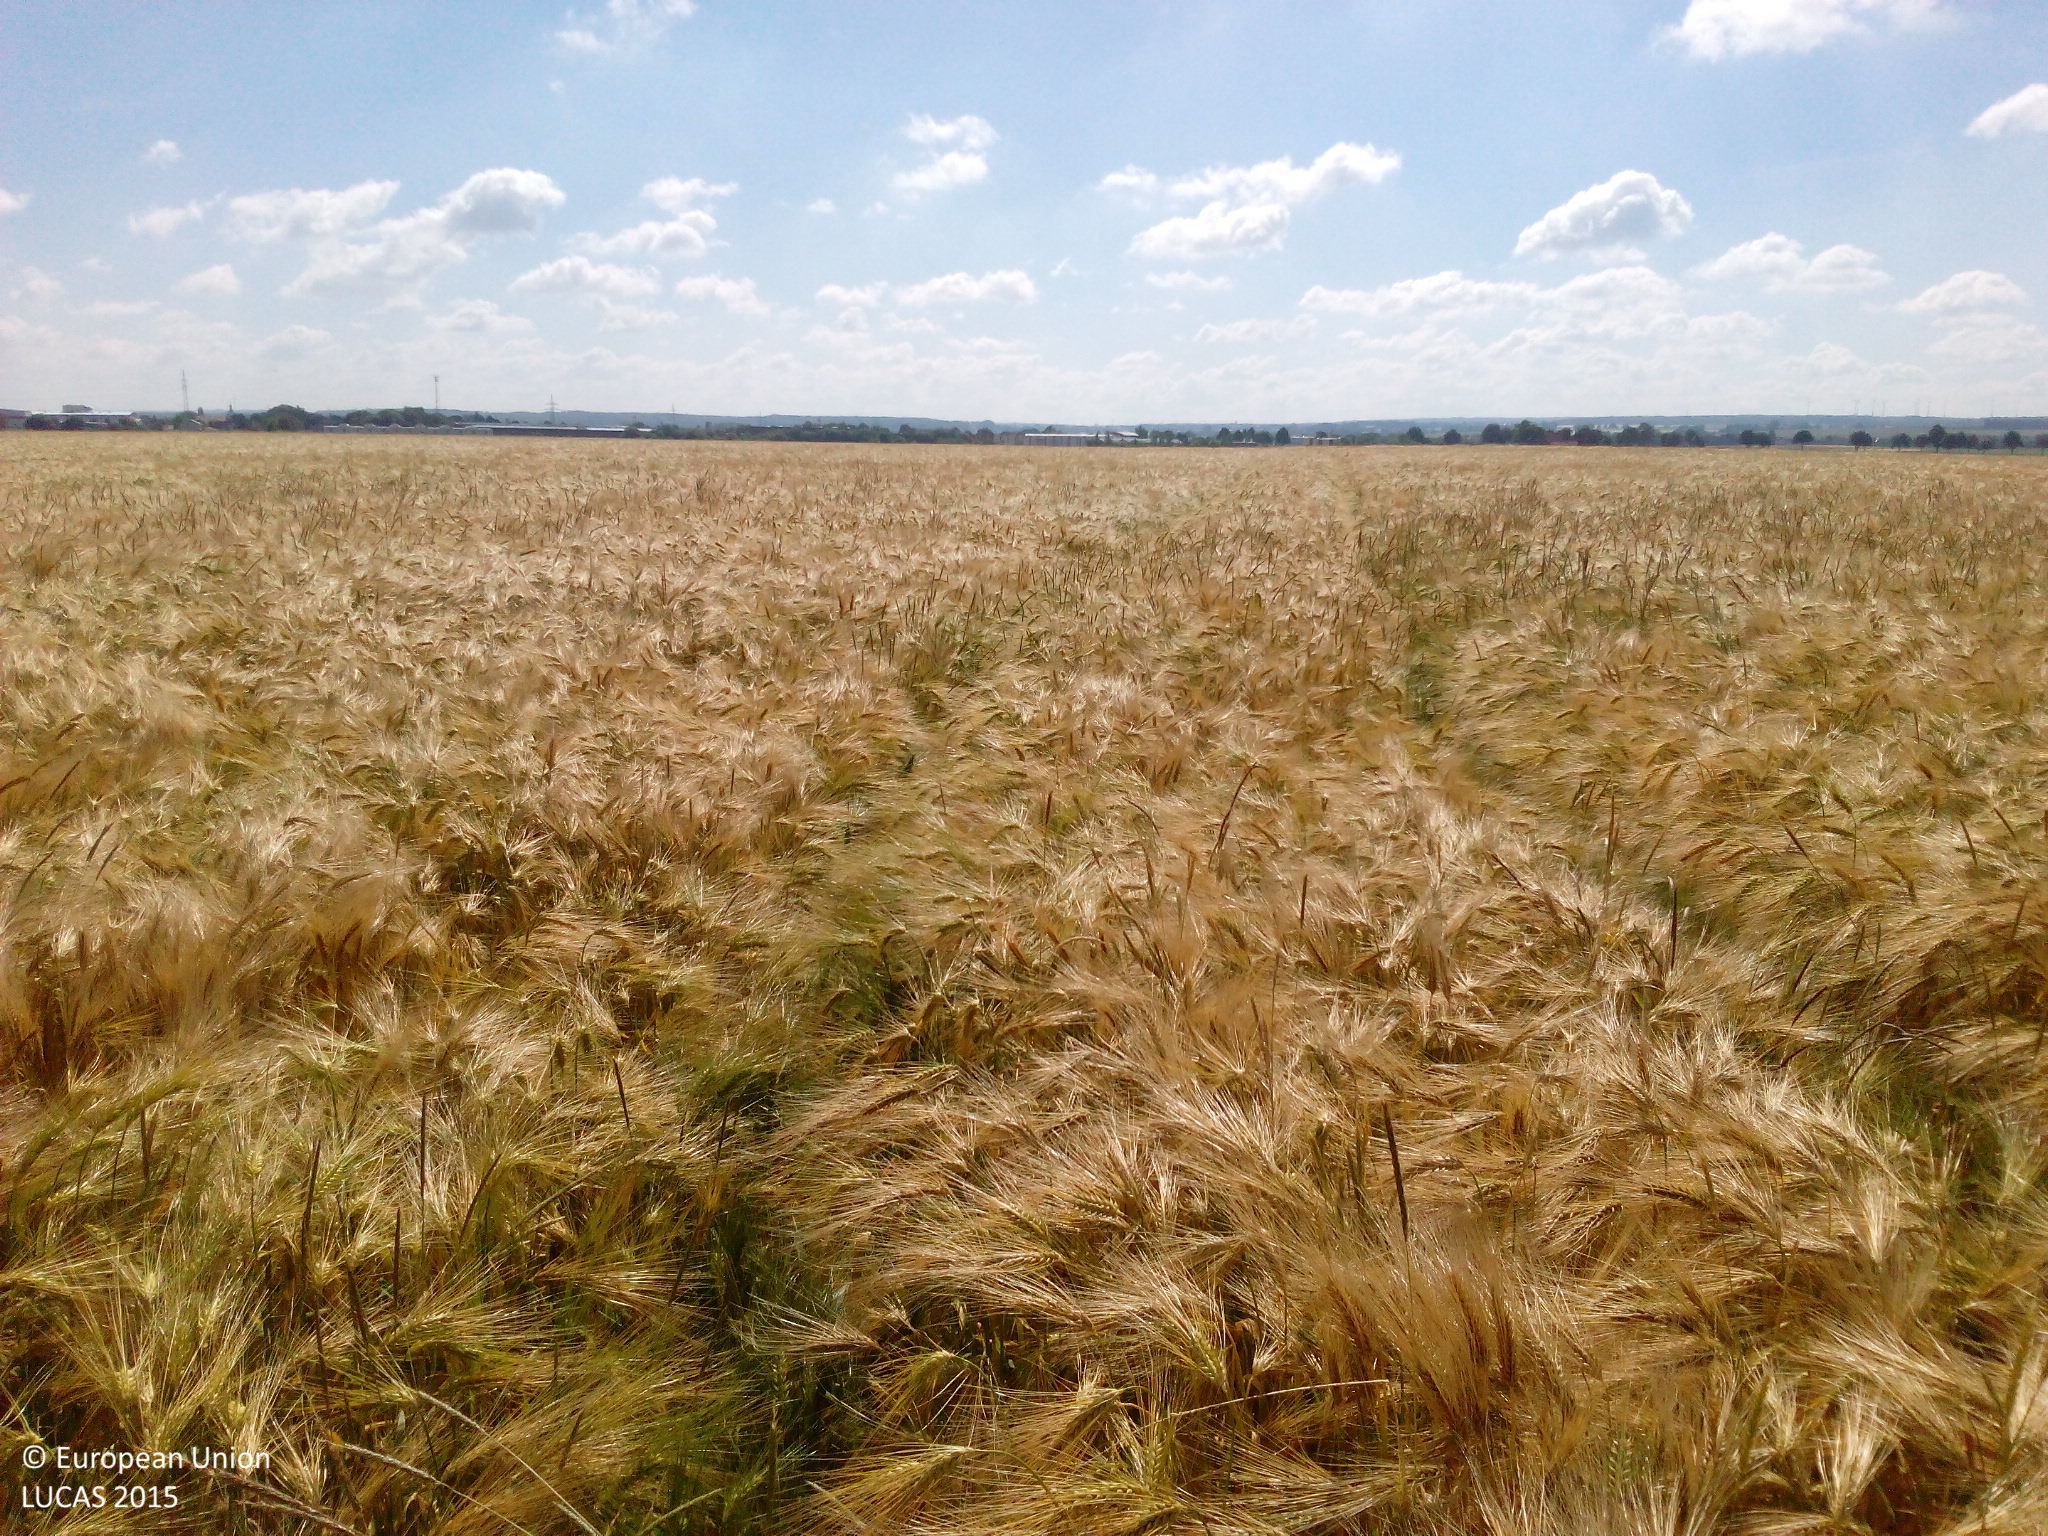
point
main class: Cropland
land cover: Barley
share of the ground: > 75 %
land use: Agriculture (excluding fallow land and kitchen gardens)
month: June
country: DE
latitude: 51.6677
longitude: 8.5690
